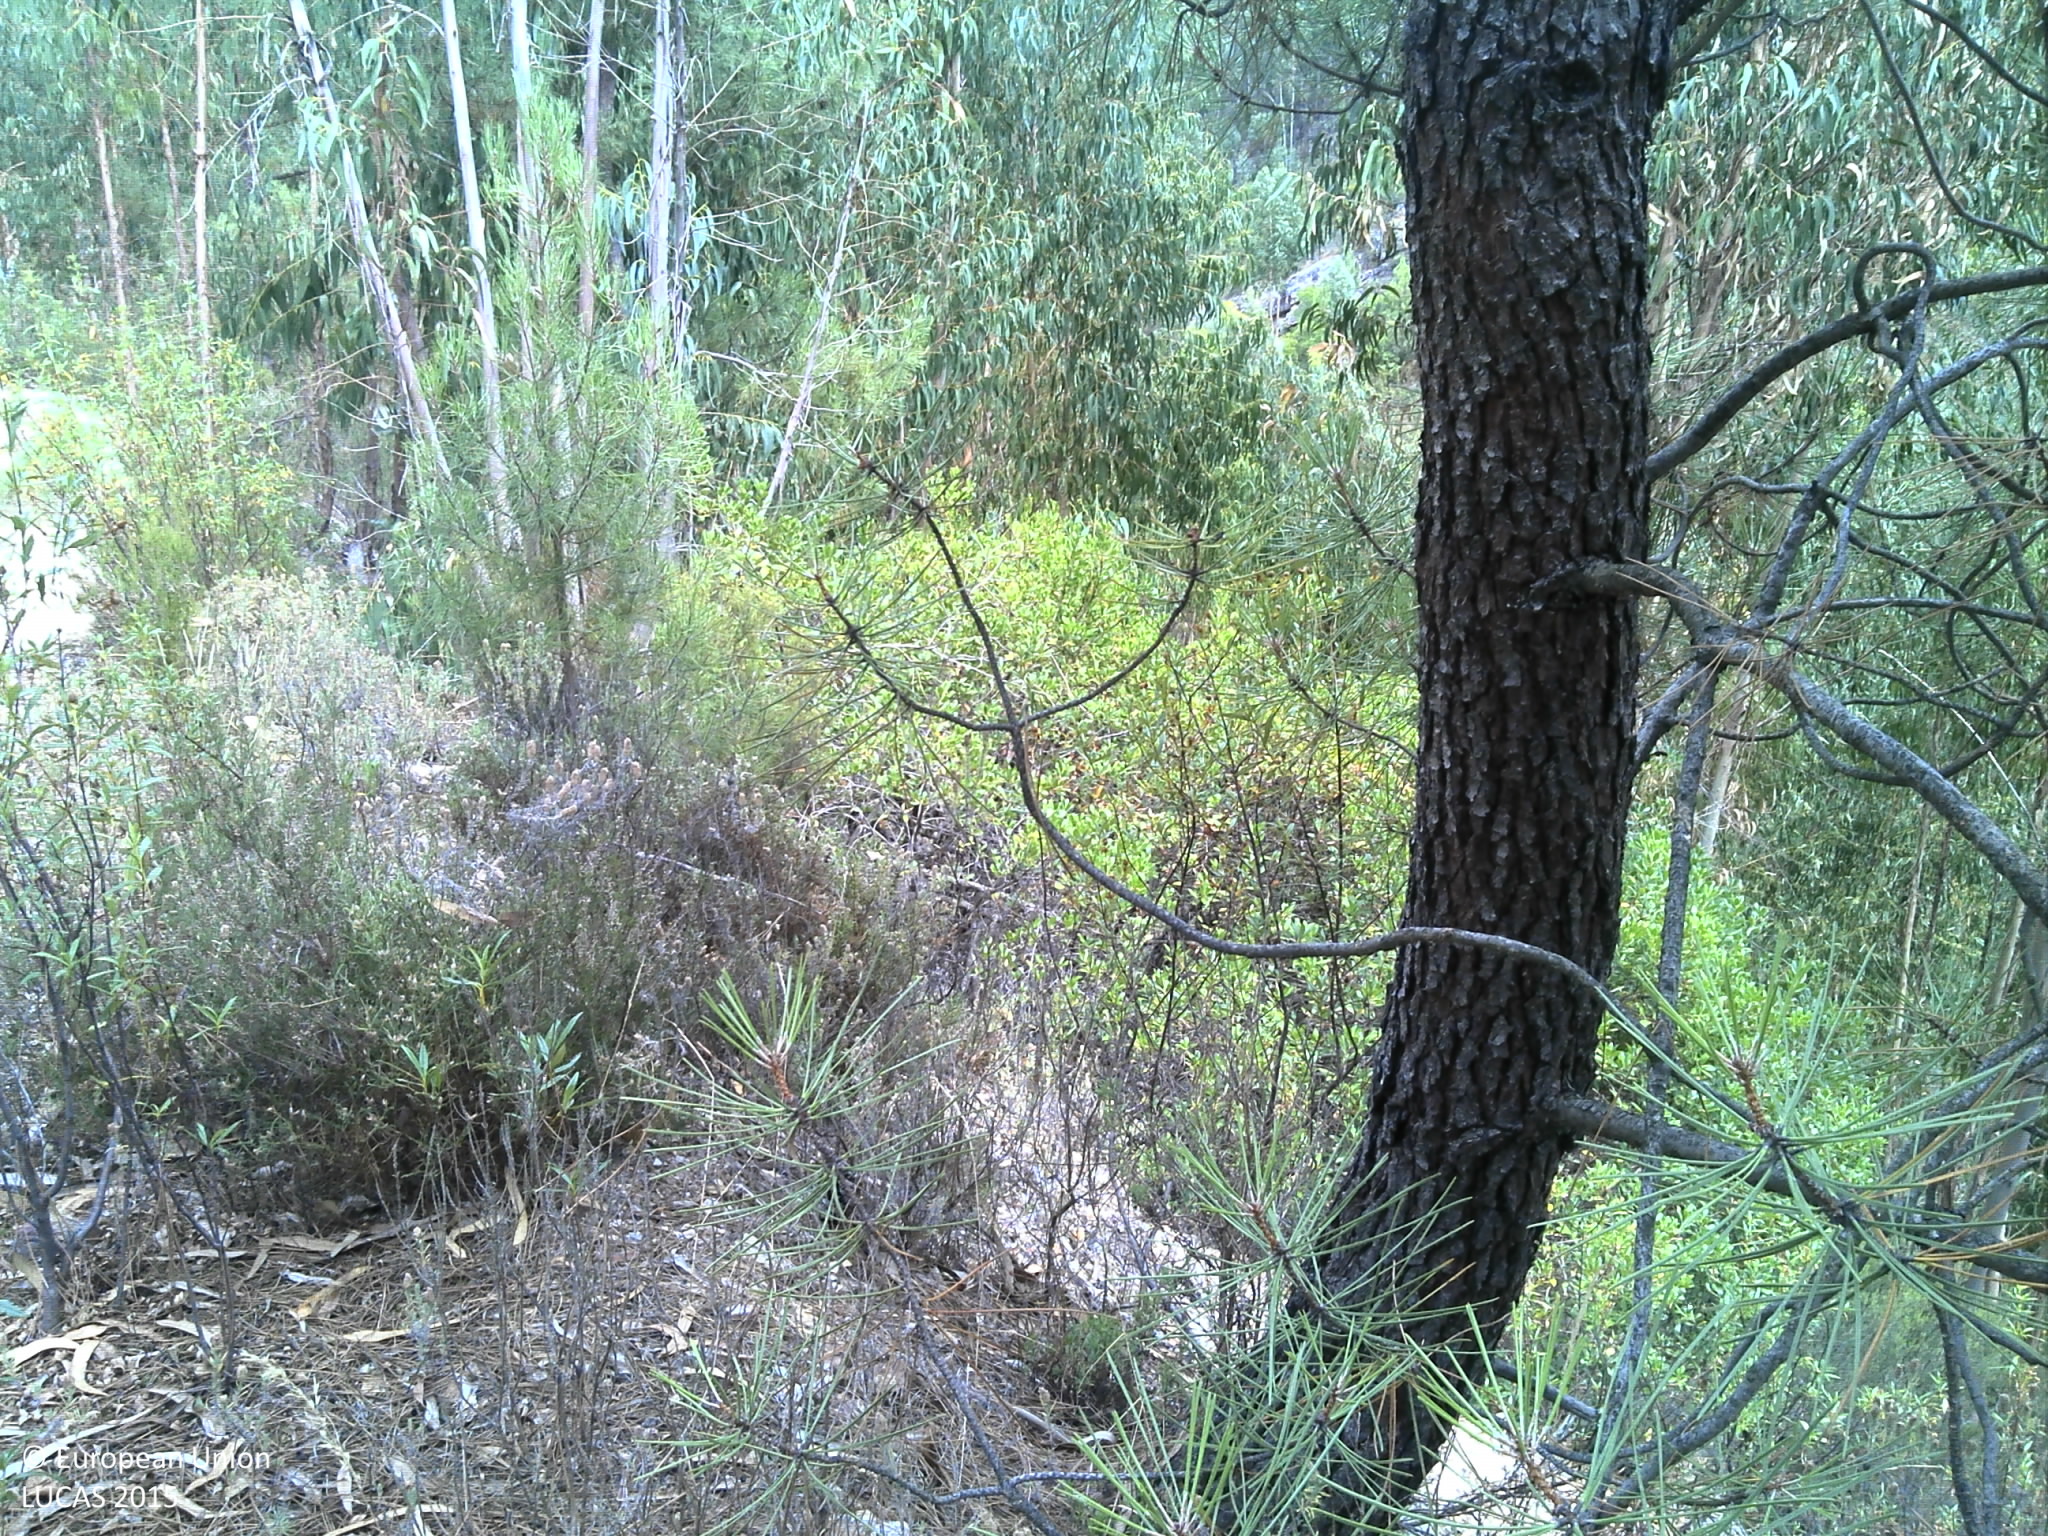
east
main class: Woodland
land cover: Pine dominated mixed woodland
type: coniferous forest of the mediterranean region
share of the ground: 25 - 50 %
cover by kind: shrubs 30 %, unconsolidated bare surface 25 %, consolidated bare surface 20 %, broadleaved forest trees 15 %, coniferous forest trees 10 %
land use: Forestry
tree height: > 5 m
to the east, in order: Pine dominated mixed woodland; Broadleaved woodland; Rock outcrops; Shrubland with sparse tree cover; Rivers and streams; Rock outcrops; Shrubland with sparse tree cover; Shrubland without tree cover; Broadleaved woodland
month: July
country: PT
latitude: 39.6153
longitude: -8.0354
